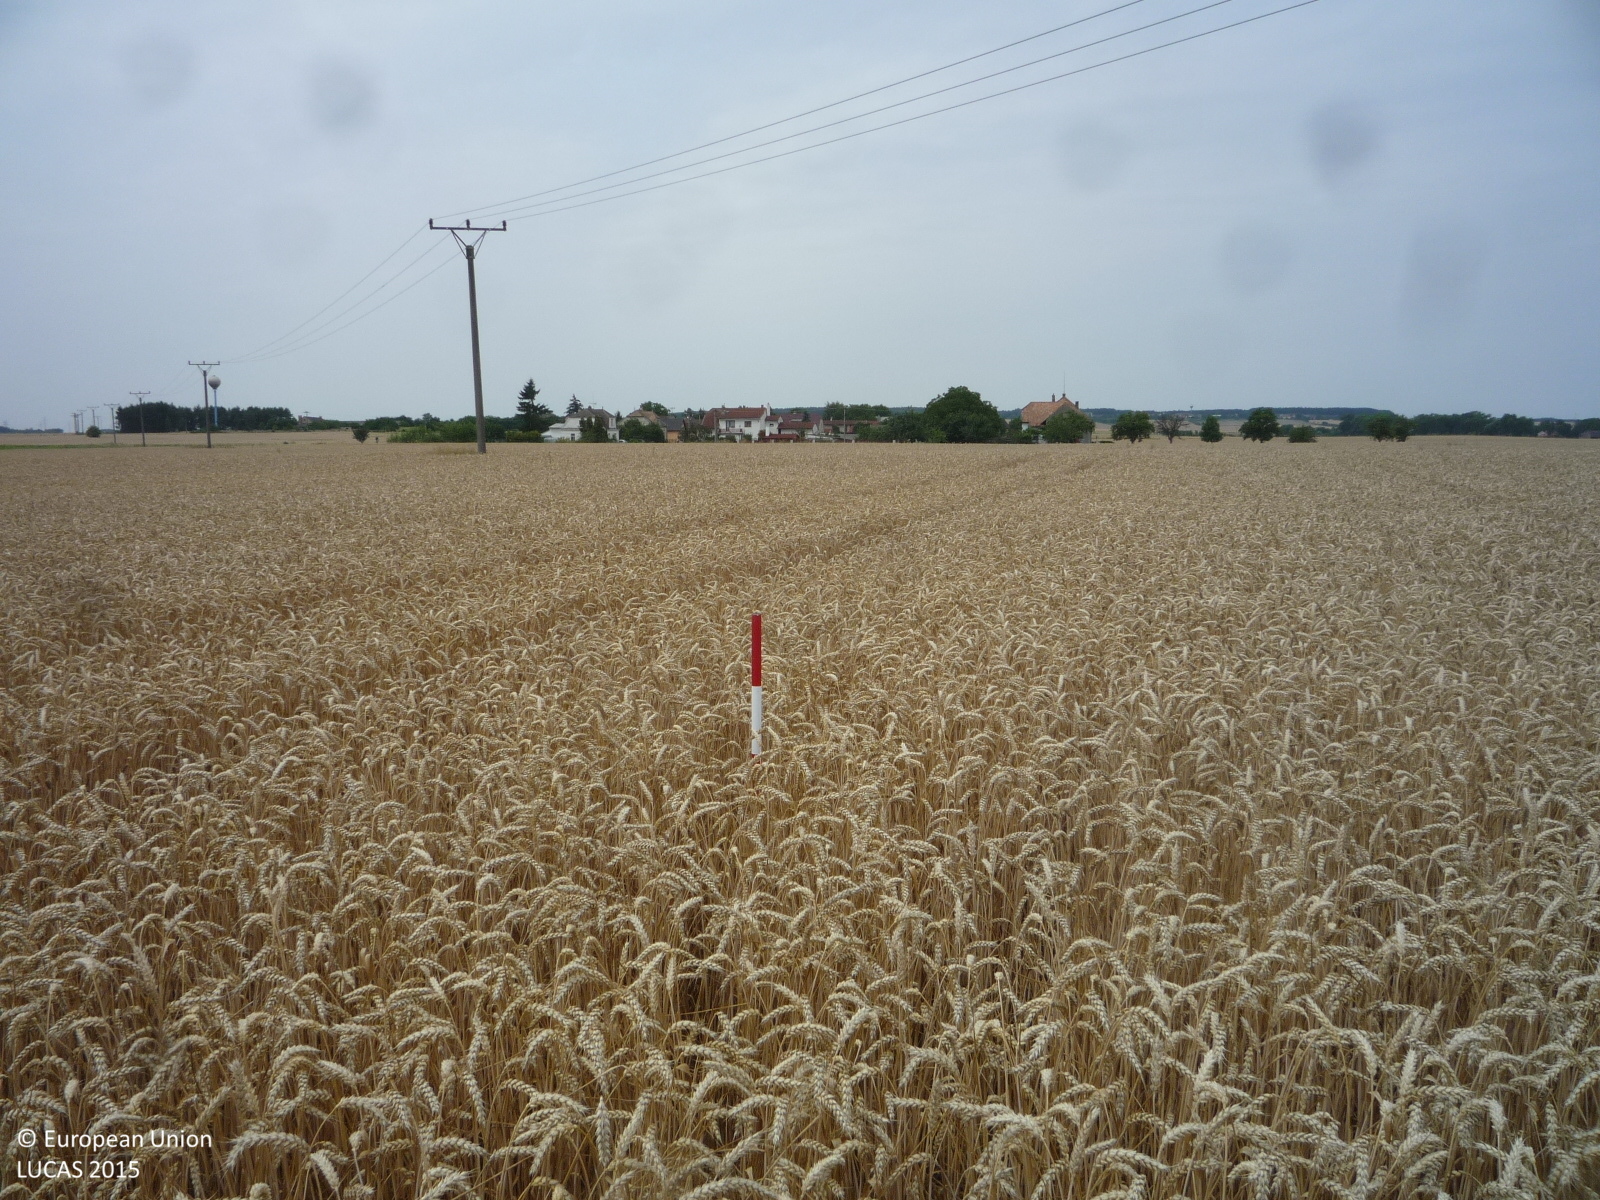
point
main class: Cropland
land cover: Common wheat
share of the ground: > 75 %
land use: Agriculture (excluding fallow land and kitchen gardens)
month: July
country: CZ
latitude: 50.3477
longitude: 14.9353
